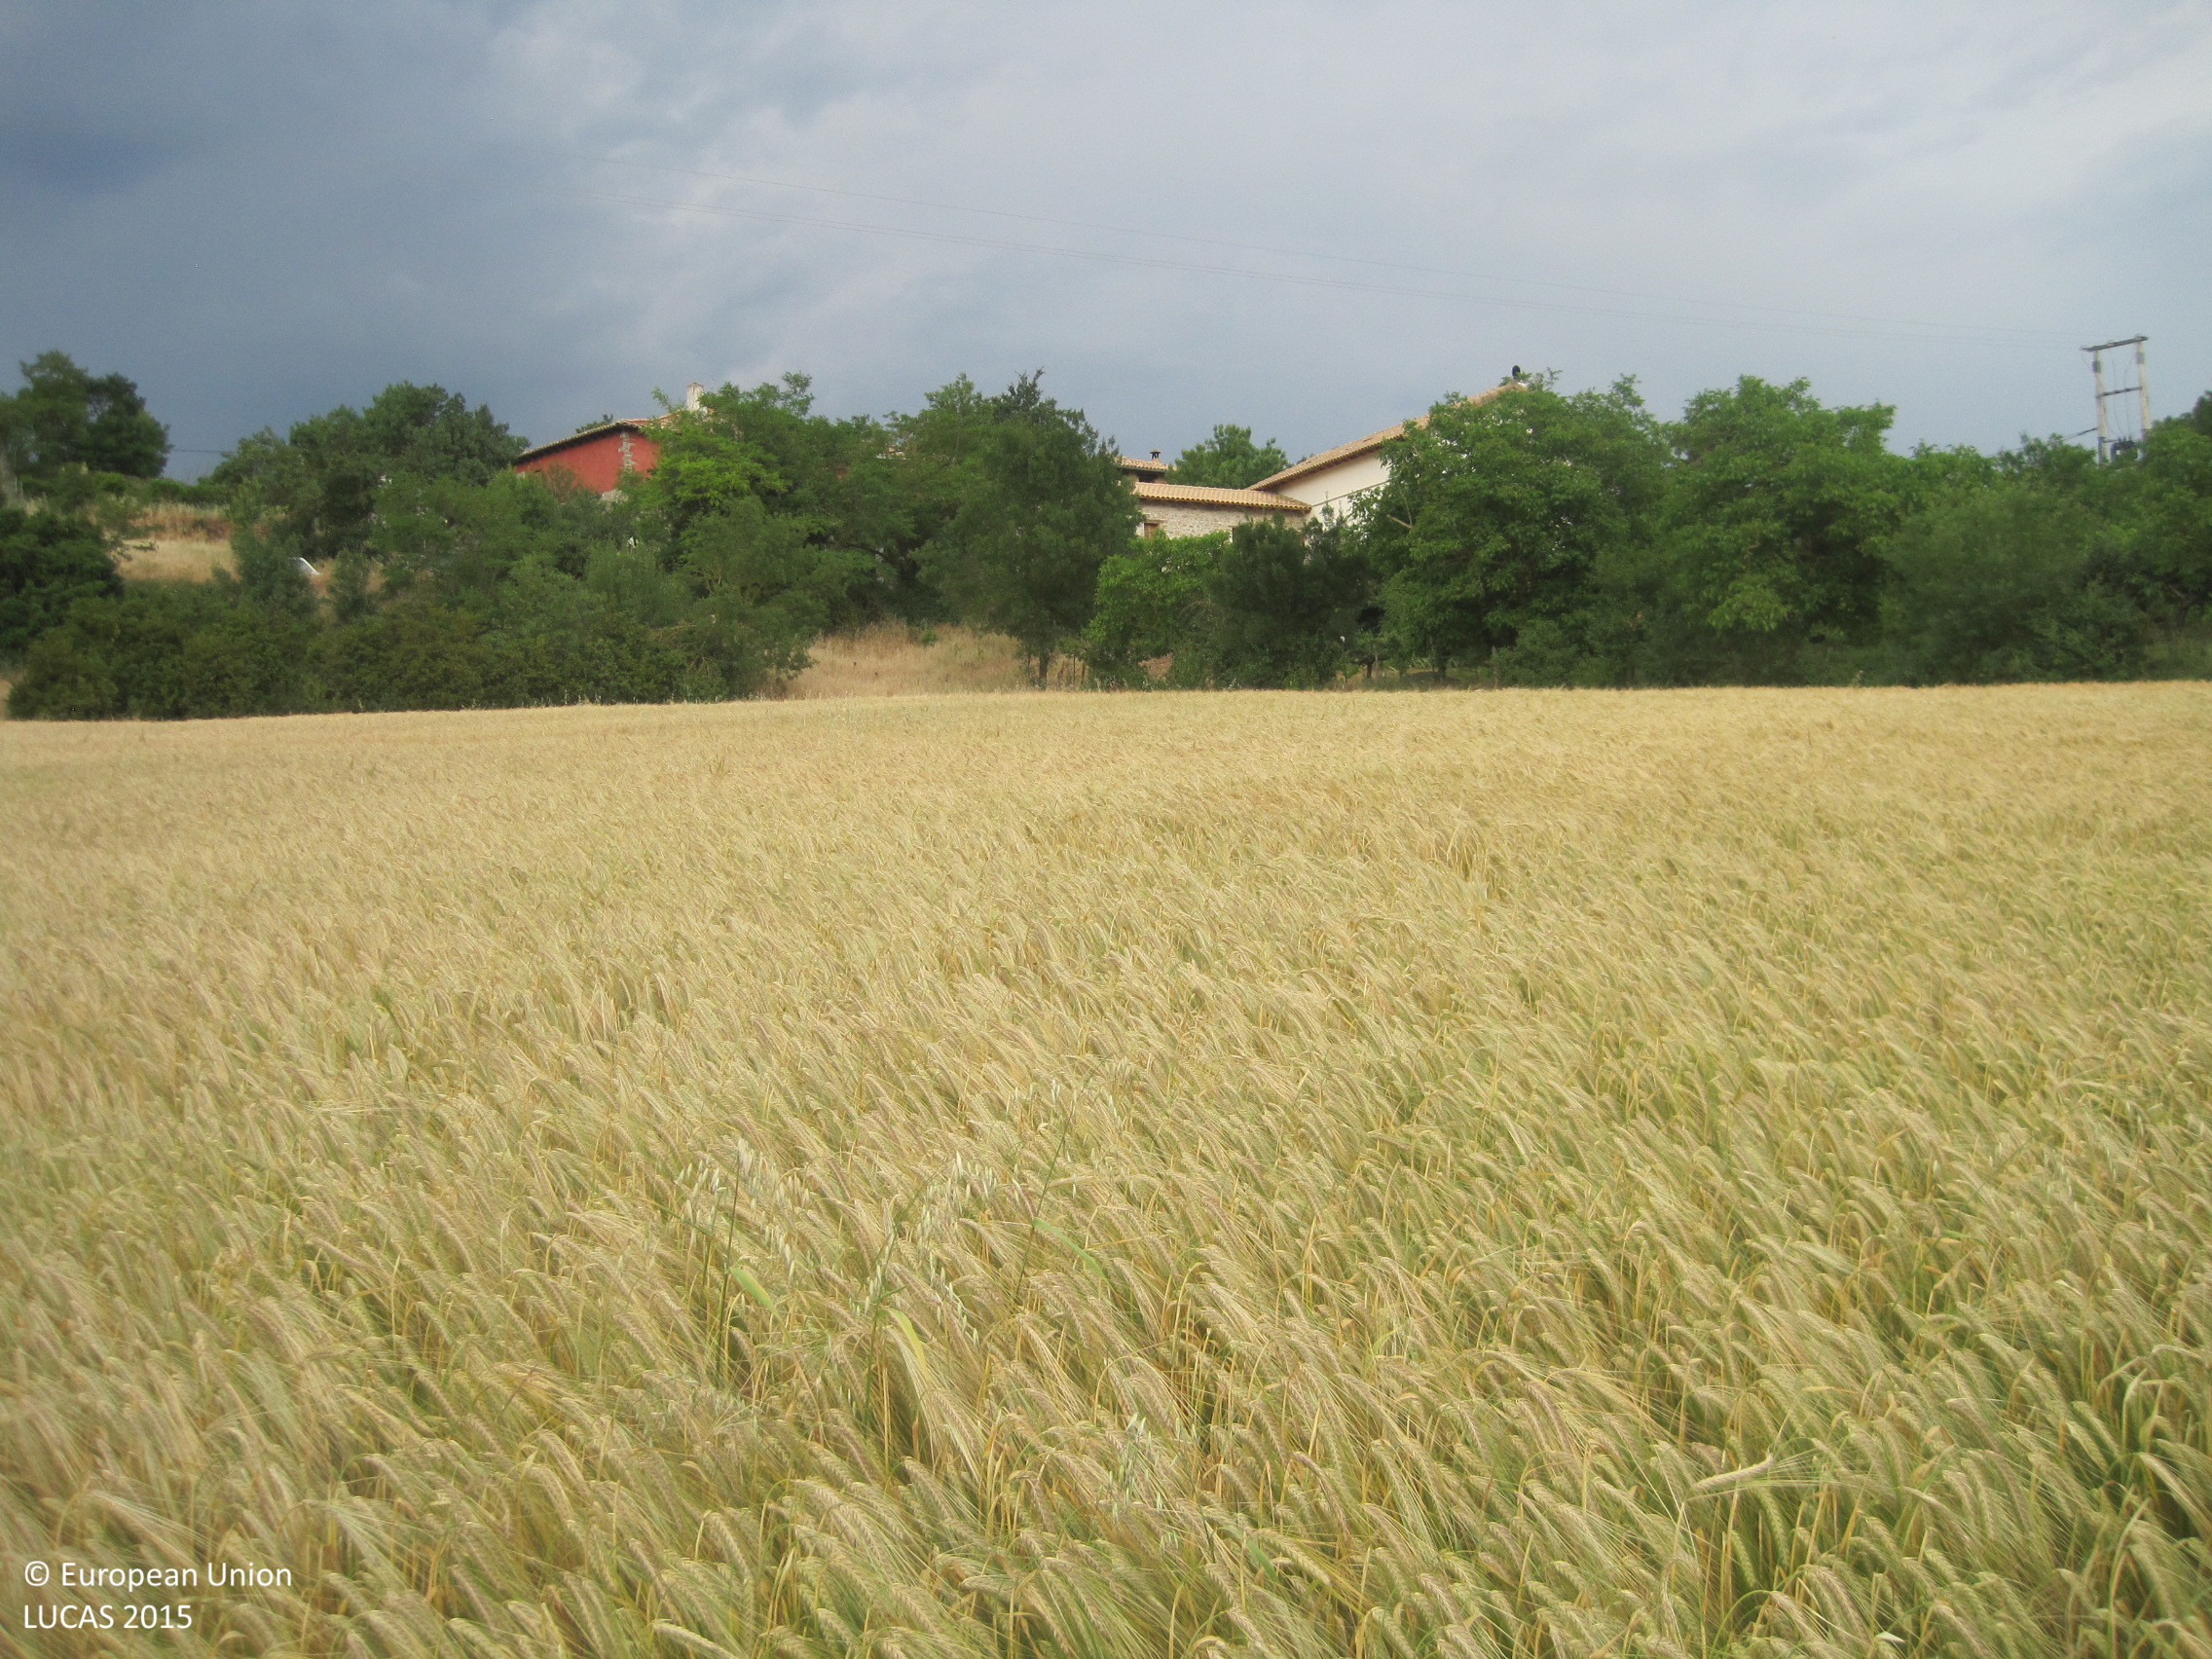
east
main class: Cropland
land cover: Barley
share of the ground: > 75 %
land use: Agriculture (excluding fallow land and kitchen gardens)
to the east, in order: Barley; Electric lines; Barley; Broadleaved woodland; Artificial constructions in urban areas; Broadleaved woodland; Common wheat; Broadleaved woodland; Tracks; Lines of trees; Barley
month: June
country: ES
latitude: 42.6659
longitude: -1.2218
